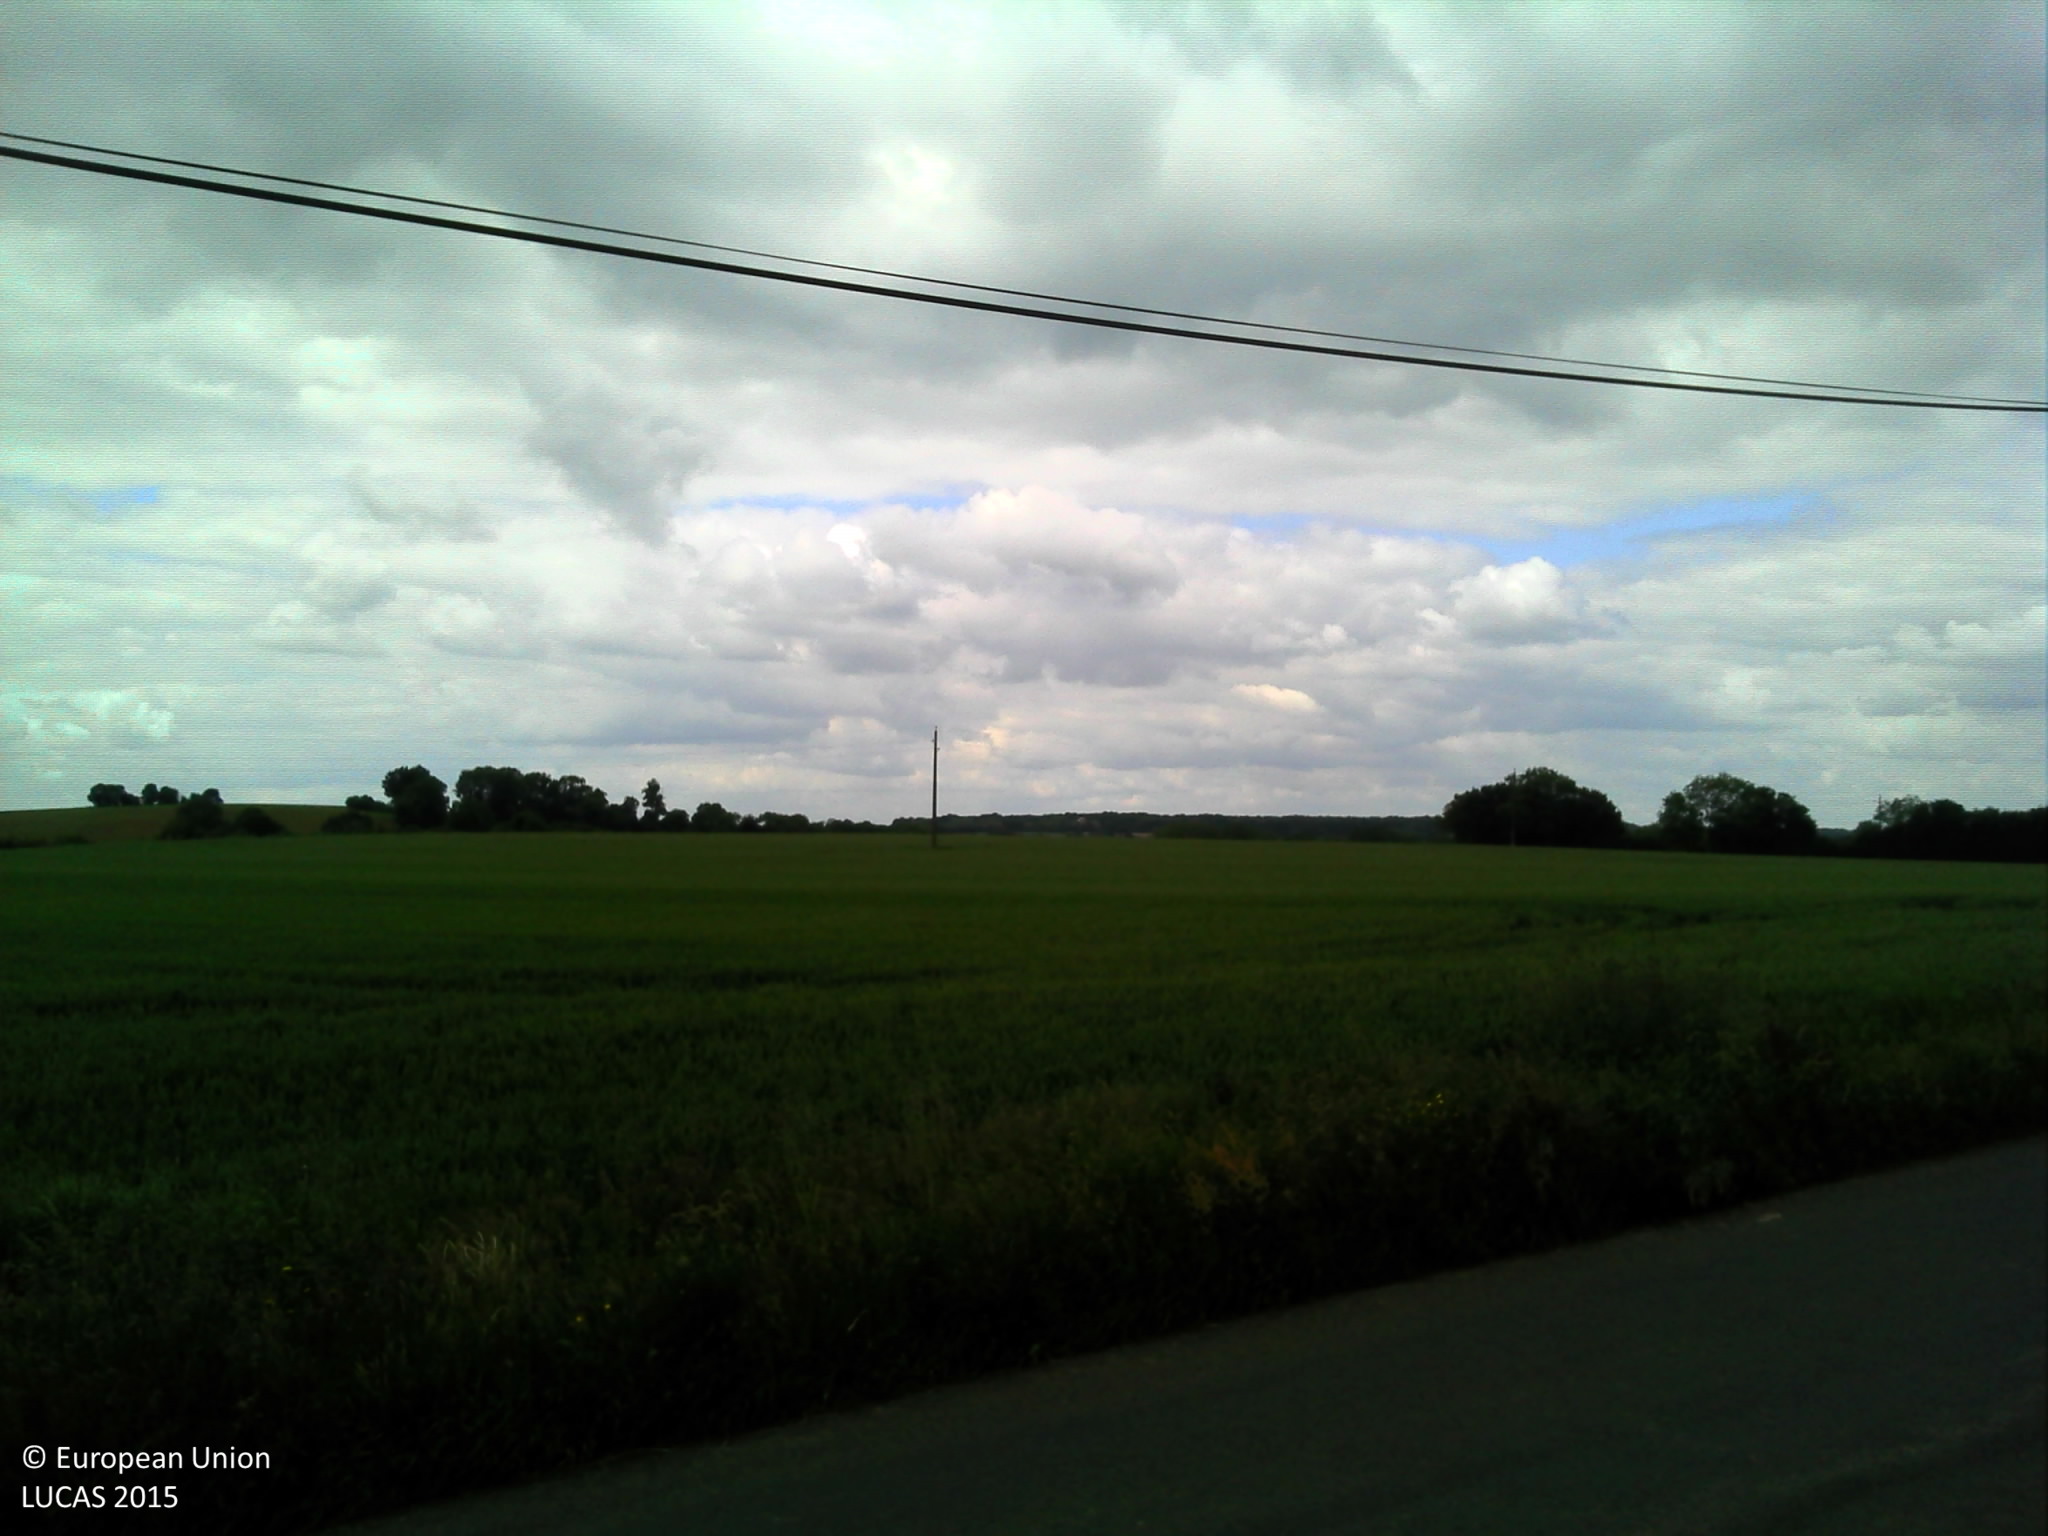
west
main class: Cropland
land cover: Common wheat
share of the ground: > 75 %
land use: Agriculture (excluding fallow land and kitchen gardens)
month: May
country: FR
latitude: 48.0305
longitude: -0.1003
